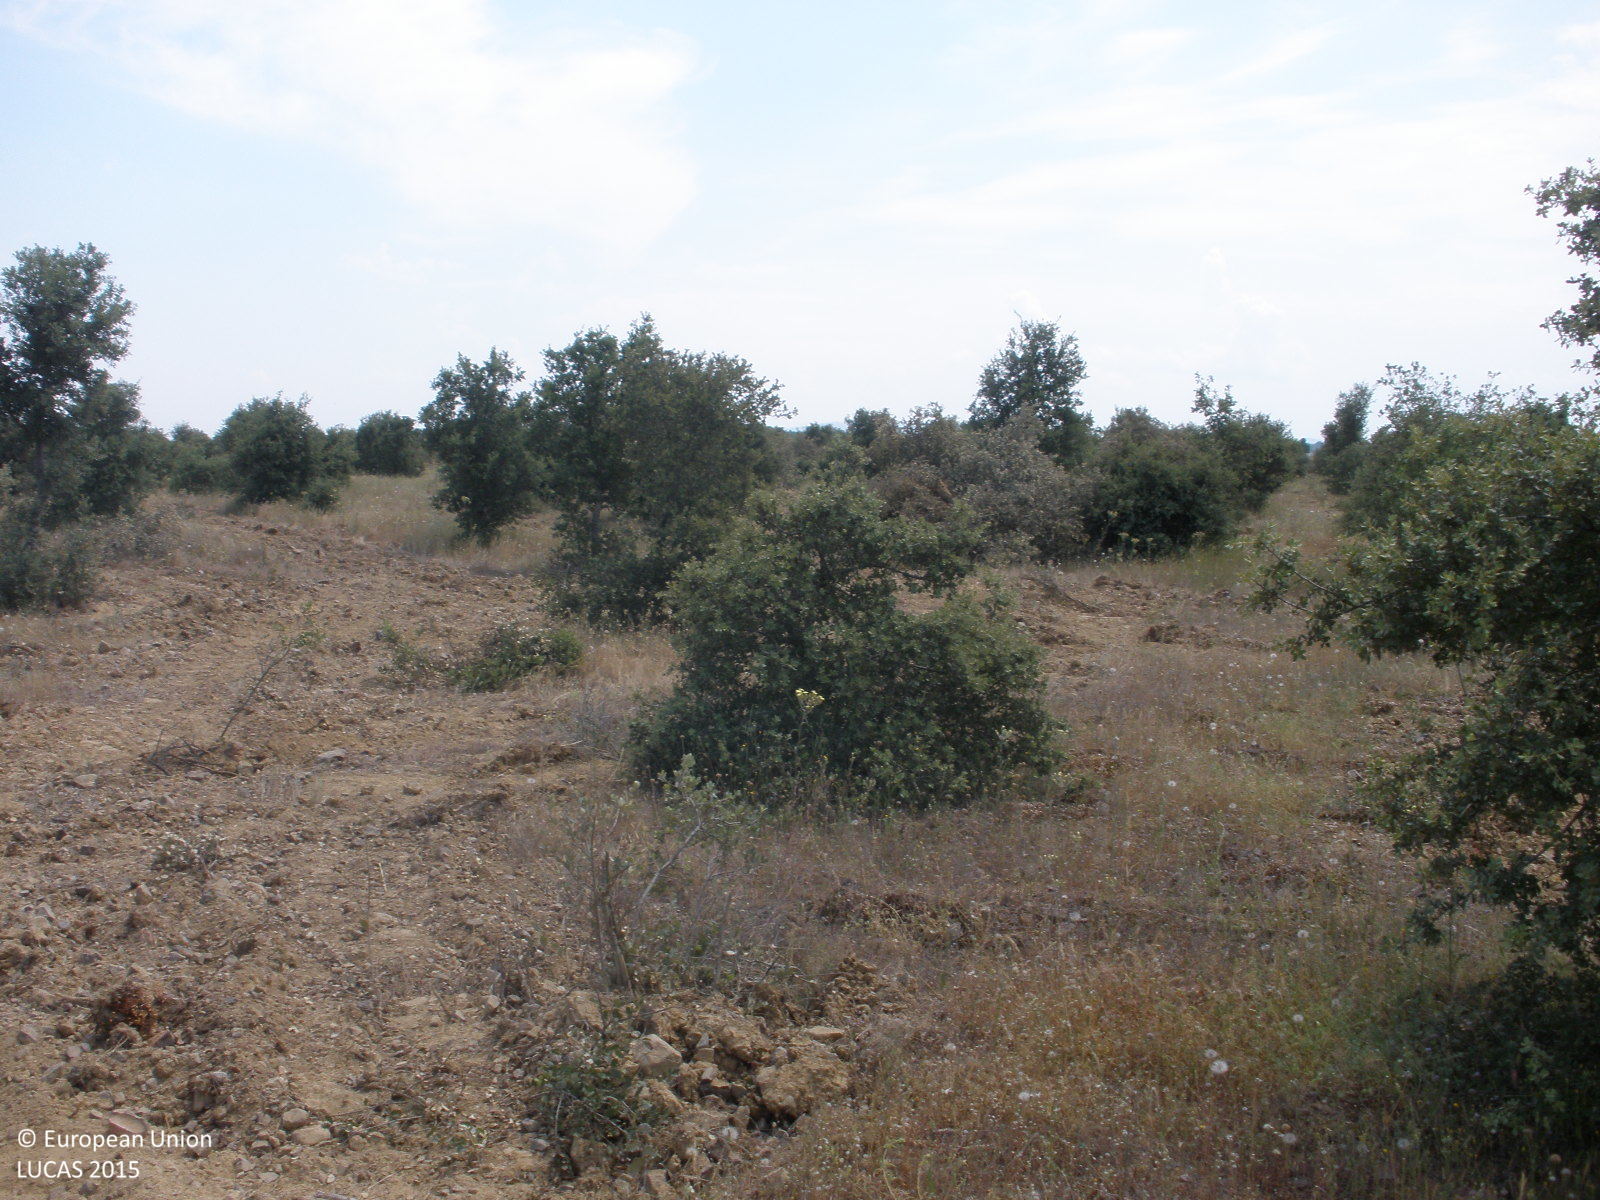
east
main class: Woodland
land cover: Broadleaved woodland
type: broadleaved evergreen forest
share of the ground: 50 - 75 %
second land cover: Spontaneously vegetated surfaces
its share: 25 - 50 %
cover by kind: broadleaved forest trees 50 %, unconsolidated bare surface 40 %, herbaceous plants 10 %
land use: Forestry
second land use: Fallow land
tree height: < 5 m
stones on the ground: > 50 %
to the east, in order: Broadleaved woodland; Spontaneously vegetated surfaces; Fences; Grassland without tree/shrub cover
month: June
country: ES
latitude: 40.6078
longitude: -6.2881
